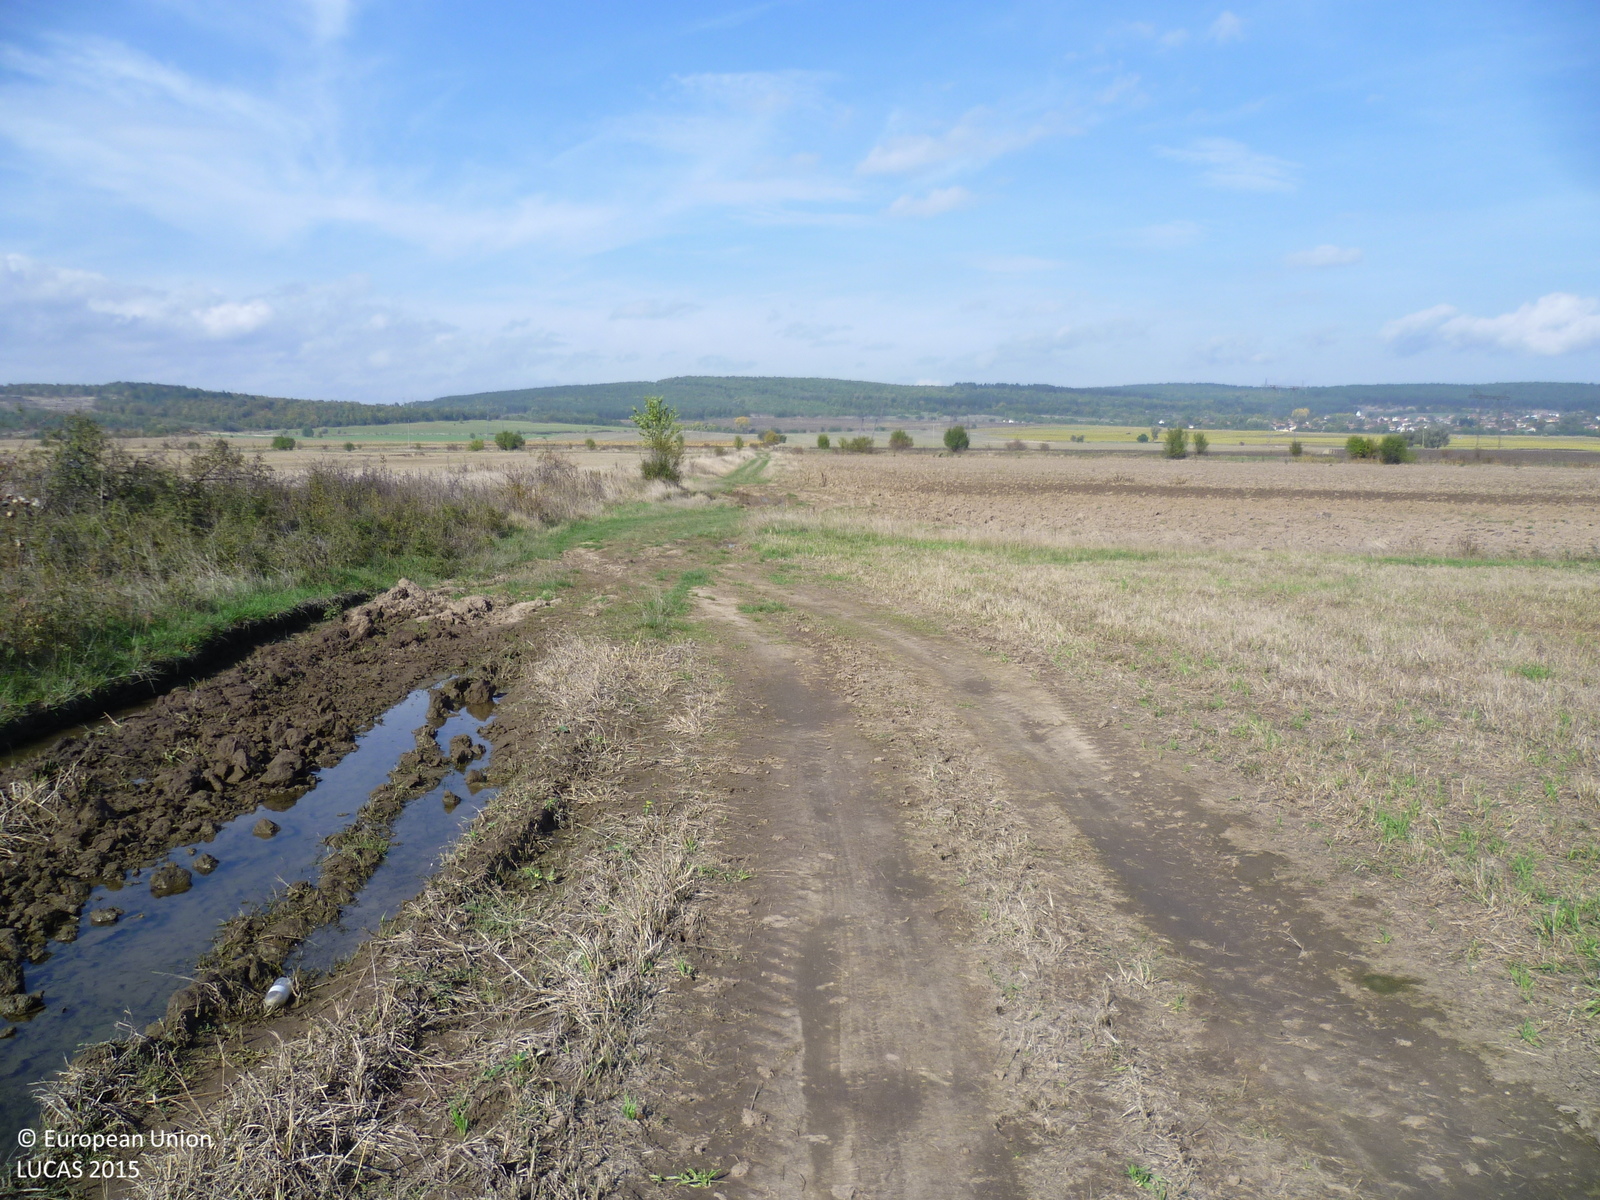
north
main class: Grassland
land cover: Grassland without tree/shrub cover
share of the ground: > 75 %
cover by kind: herbaceous plants 100 %
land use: Agriculture (excluding fallow land and kitchen gardens)
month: October
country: BG
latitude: 42.4621
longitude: 23.7438
